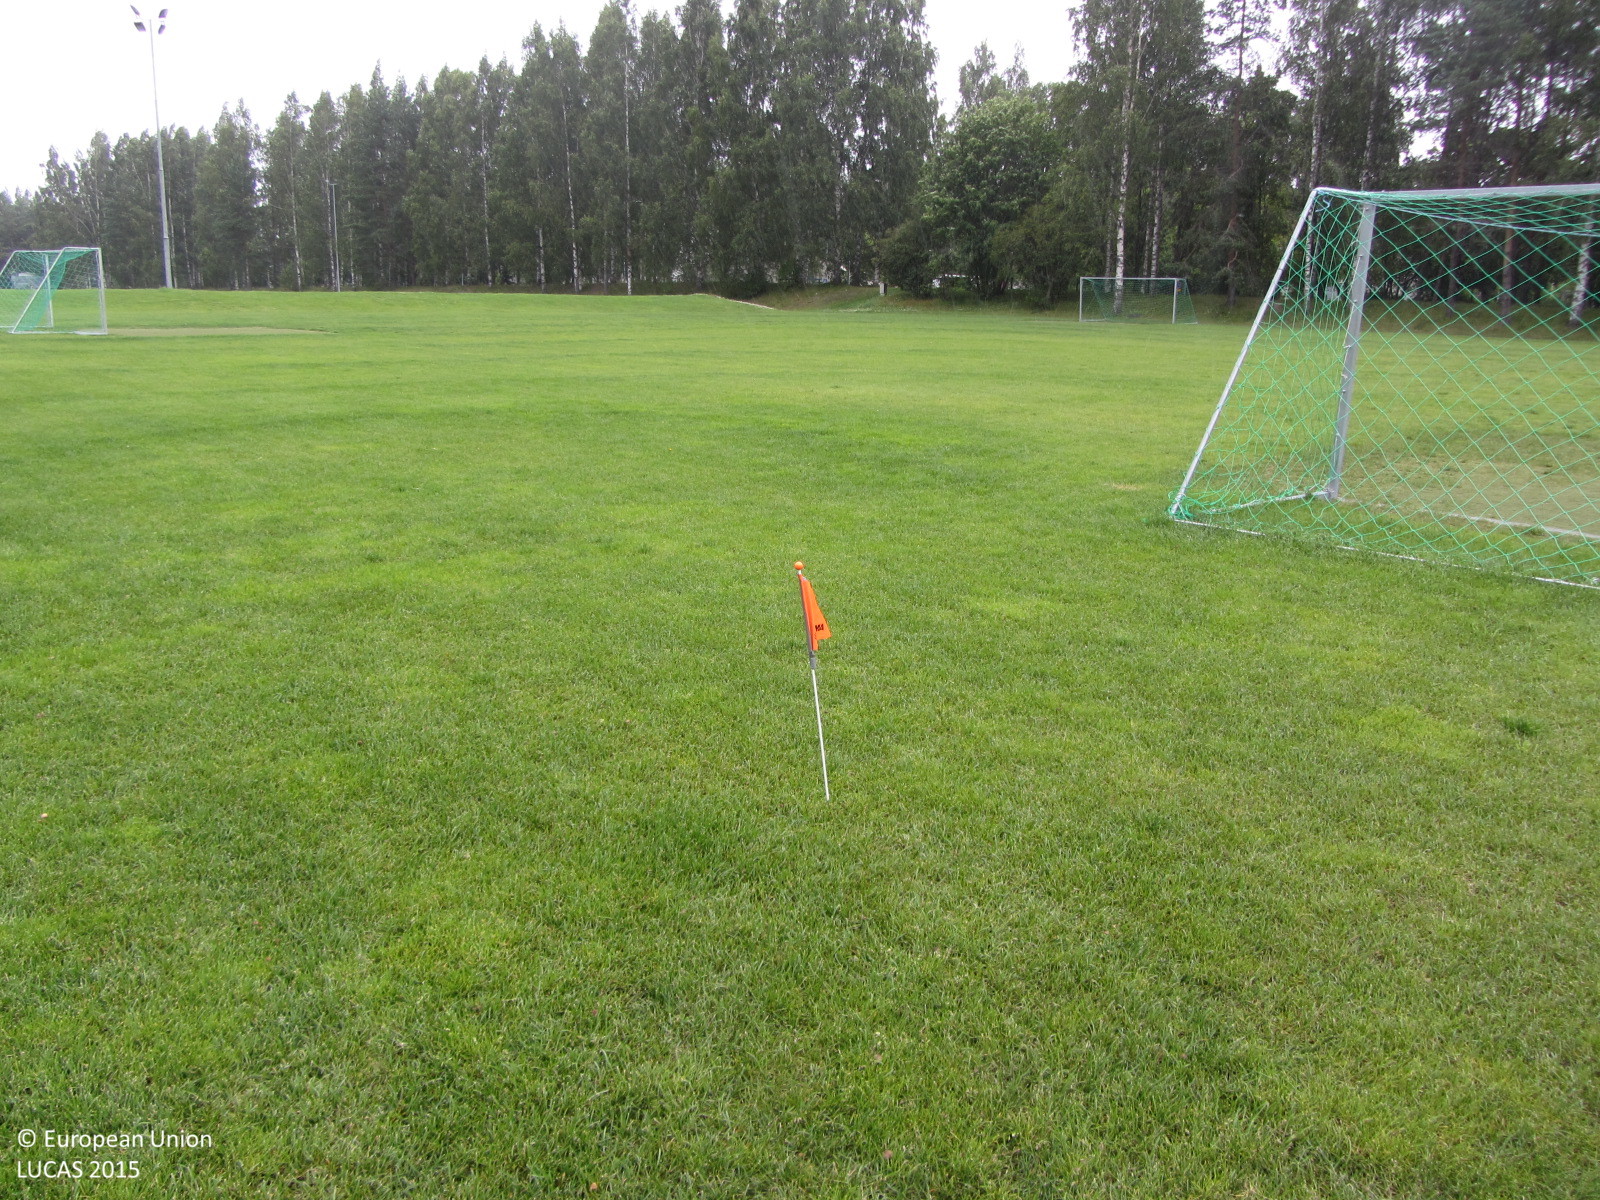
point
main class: Grassland
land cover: Grassland without tree/shrub cover
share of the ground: > 75 %
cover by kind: herbaceous plants 100 %
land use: Sport
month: July
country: FI
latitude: 60.6395
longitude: 24.8312
